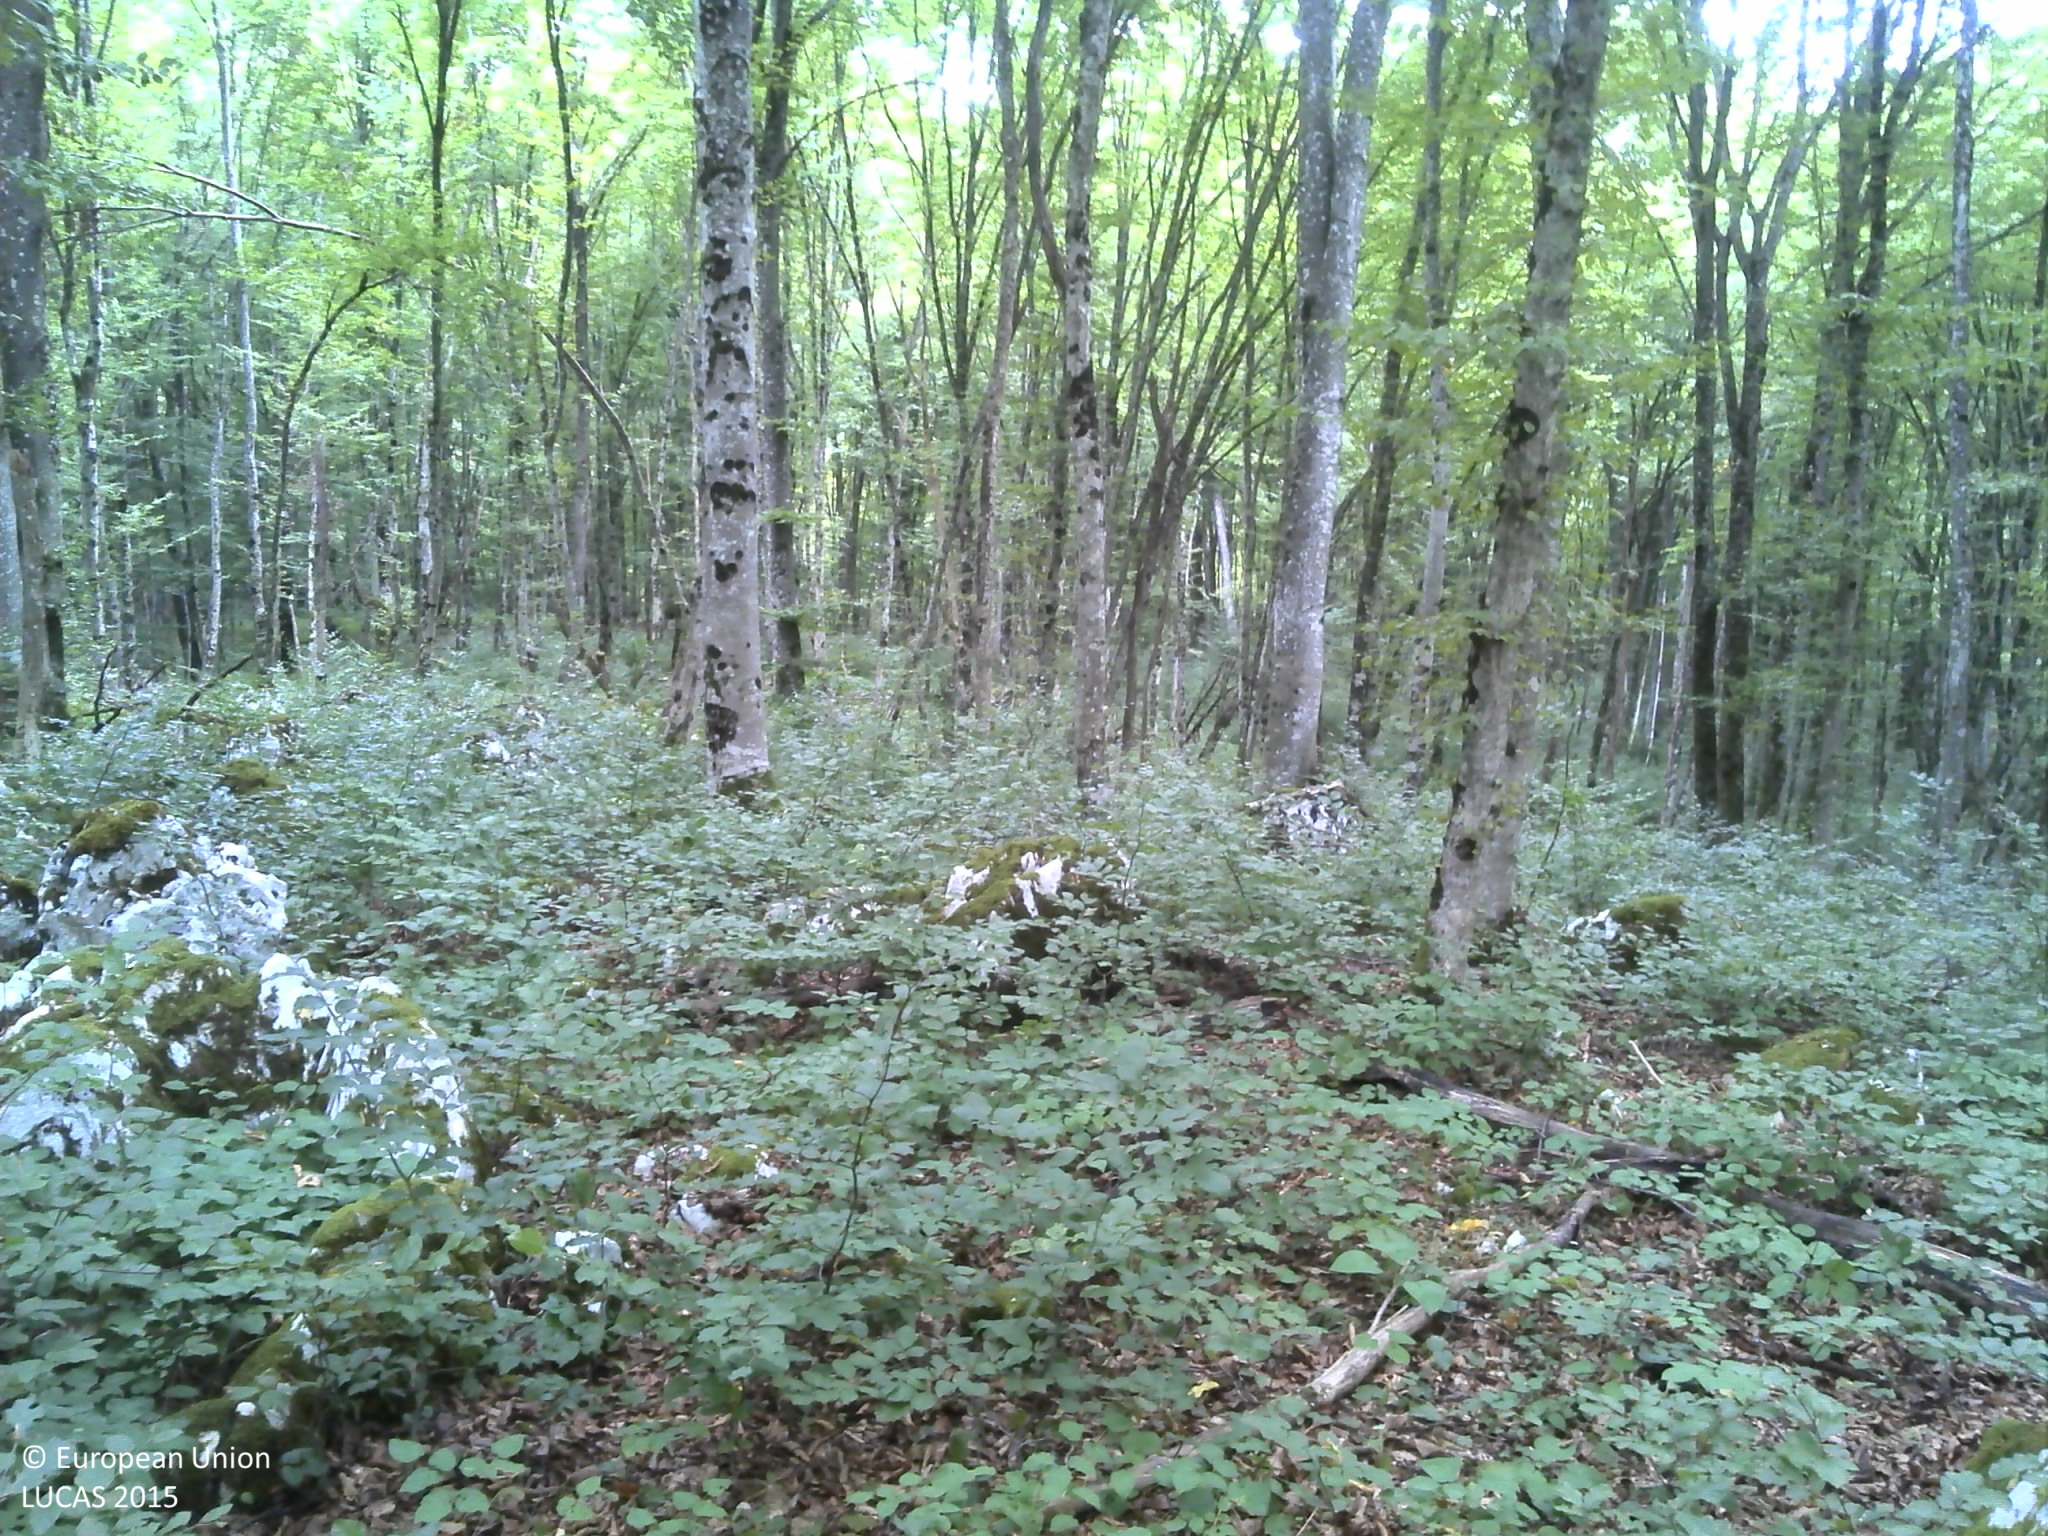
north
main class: Woodland
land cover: Broadleaved woodland
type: acidophilous oak and oak-birch forest
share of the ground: > 75 %
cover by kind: broadleaved forest trees 100 %
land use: Forestry
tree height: > 5 m
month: September
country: HR
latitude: 45.4101
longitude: 15.2471
